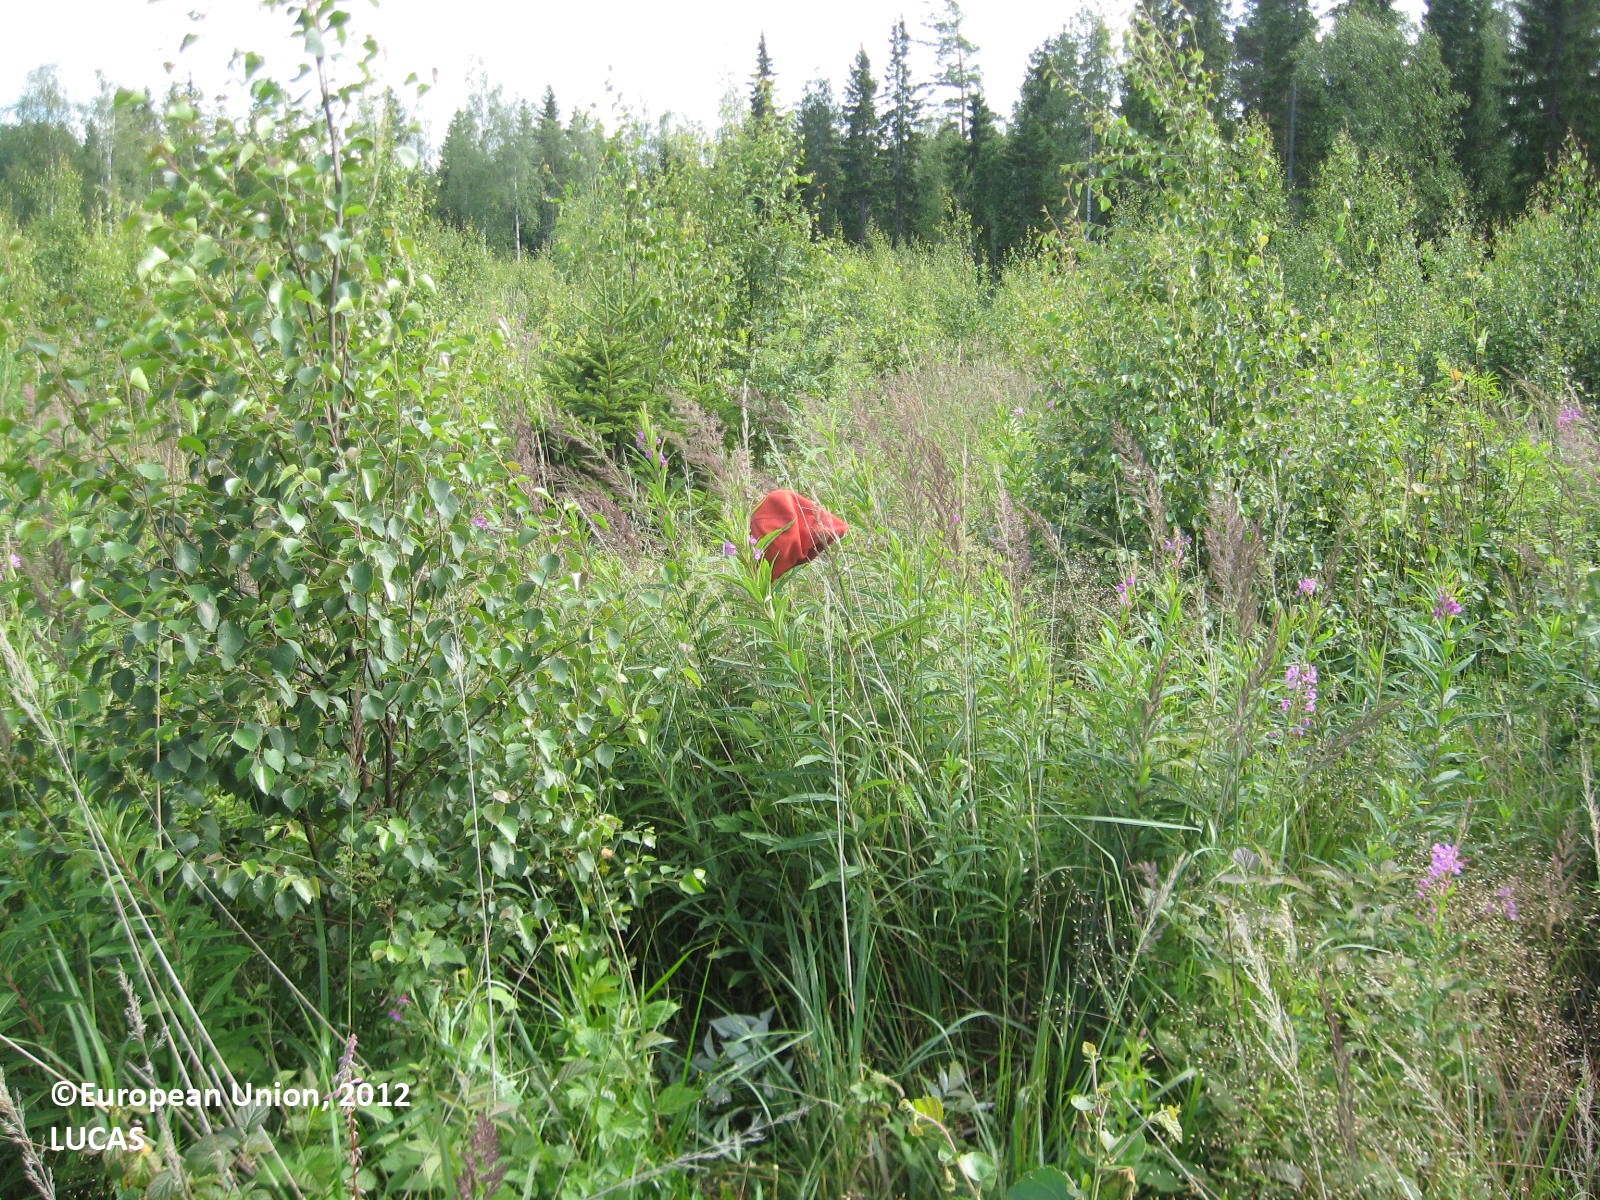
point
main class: Woodland
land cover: Other mixed woodland
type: boreal forest
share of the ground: 50 - 75 %
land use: Forestry
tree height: < 5 m
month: July
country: FI
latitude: 62.0100
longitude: 21.4491
